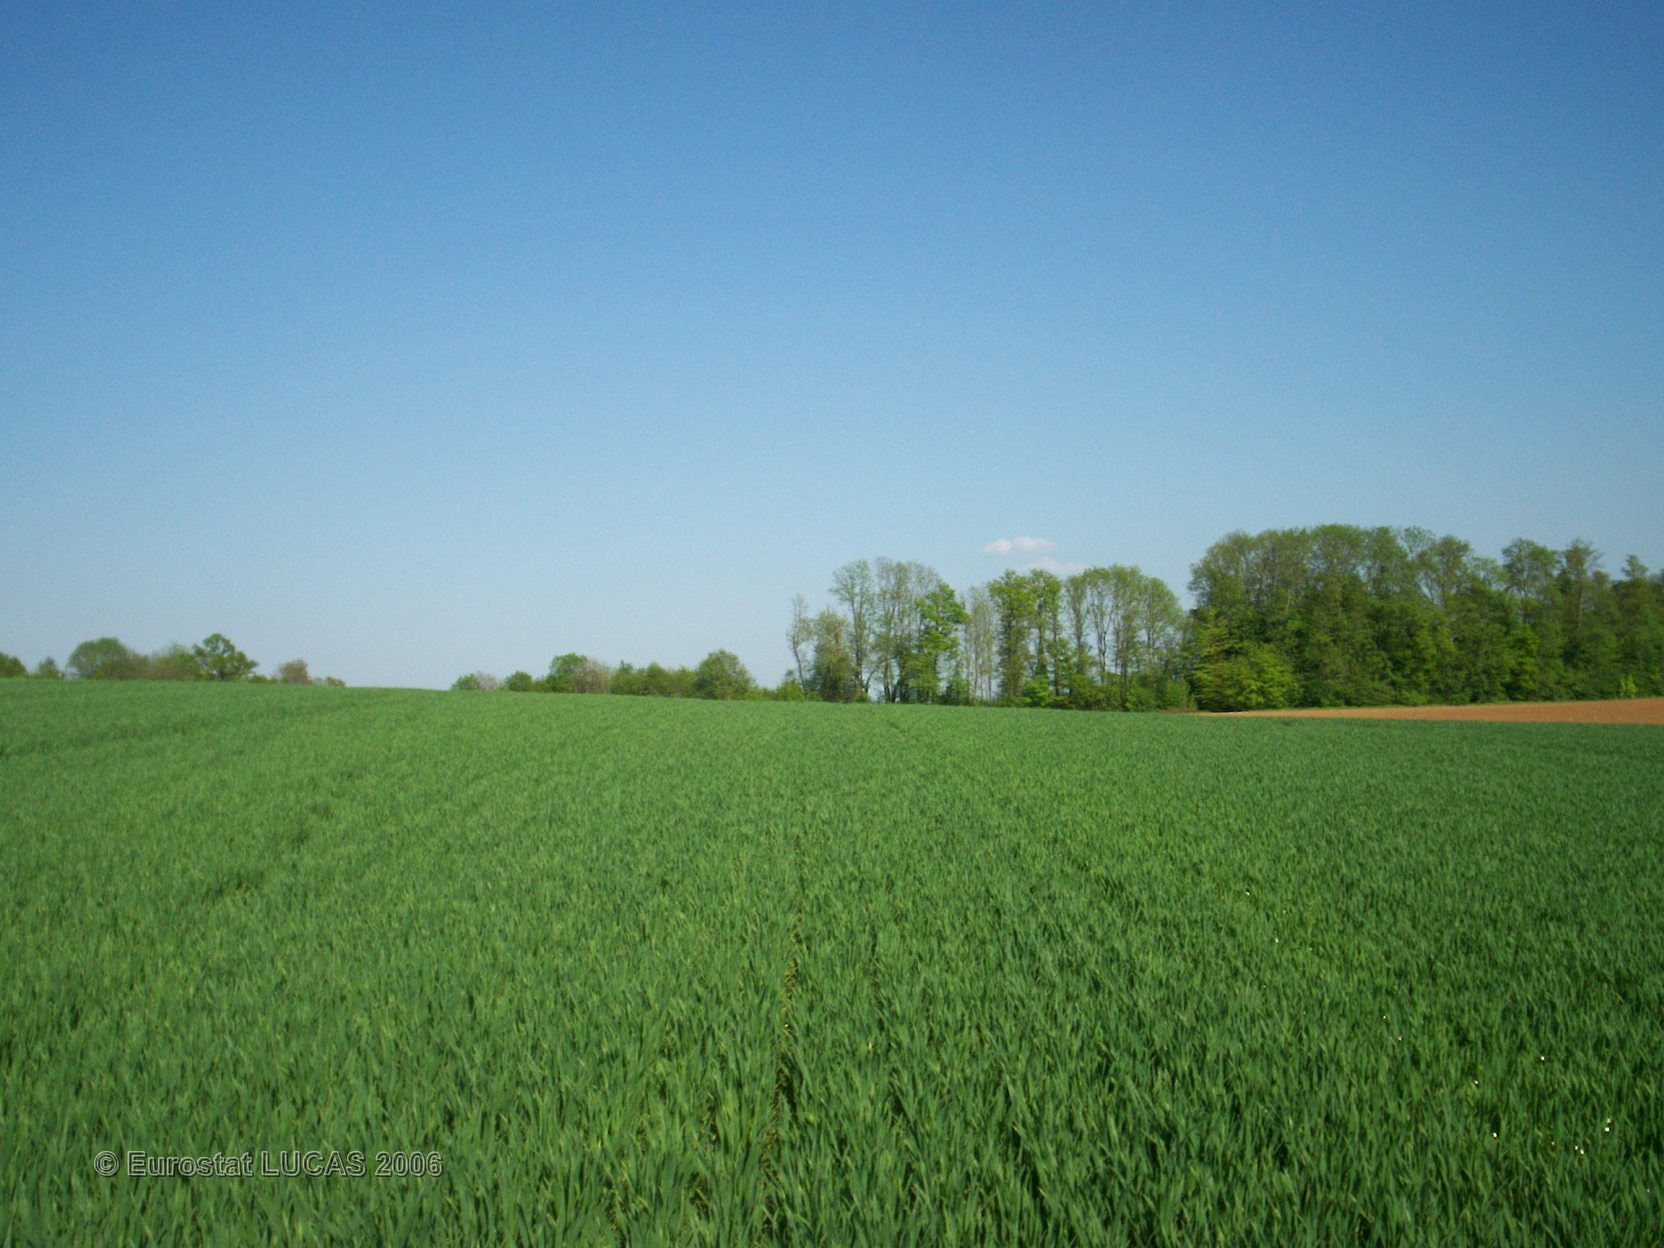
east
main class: Cropland
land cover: Common wheat
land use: Agriculture (excluding fallow land and kitchen gardens)
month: May
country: FR
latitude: 49.7151
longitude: 5.0185
